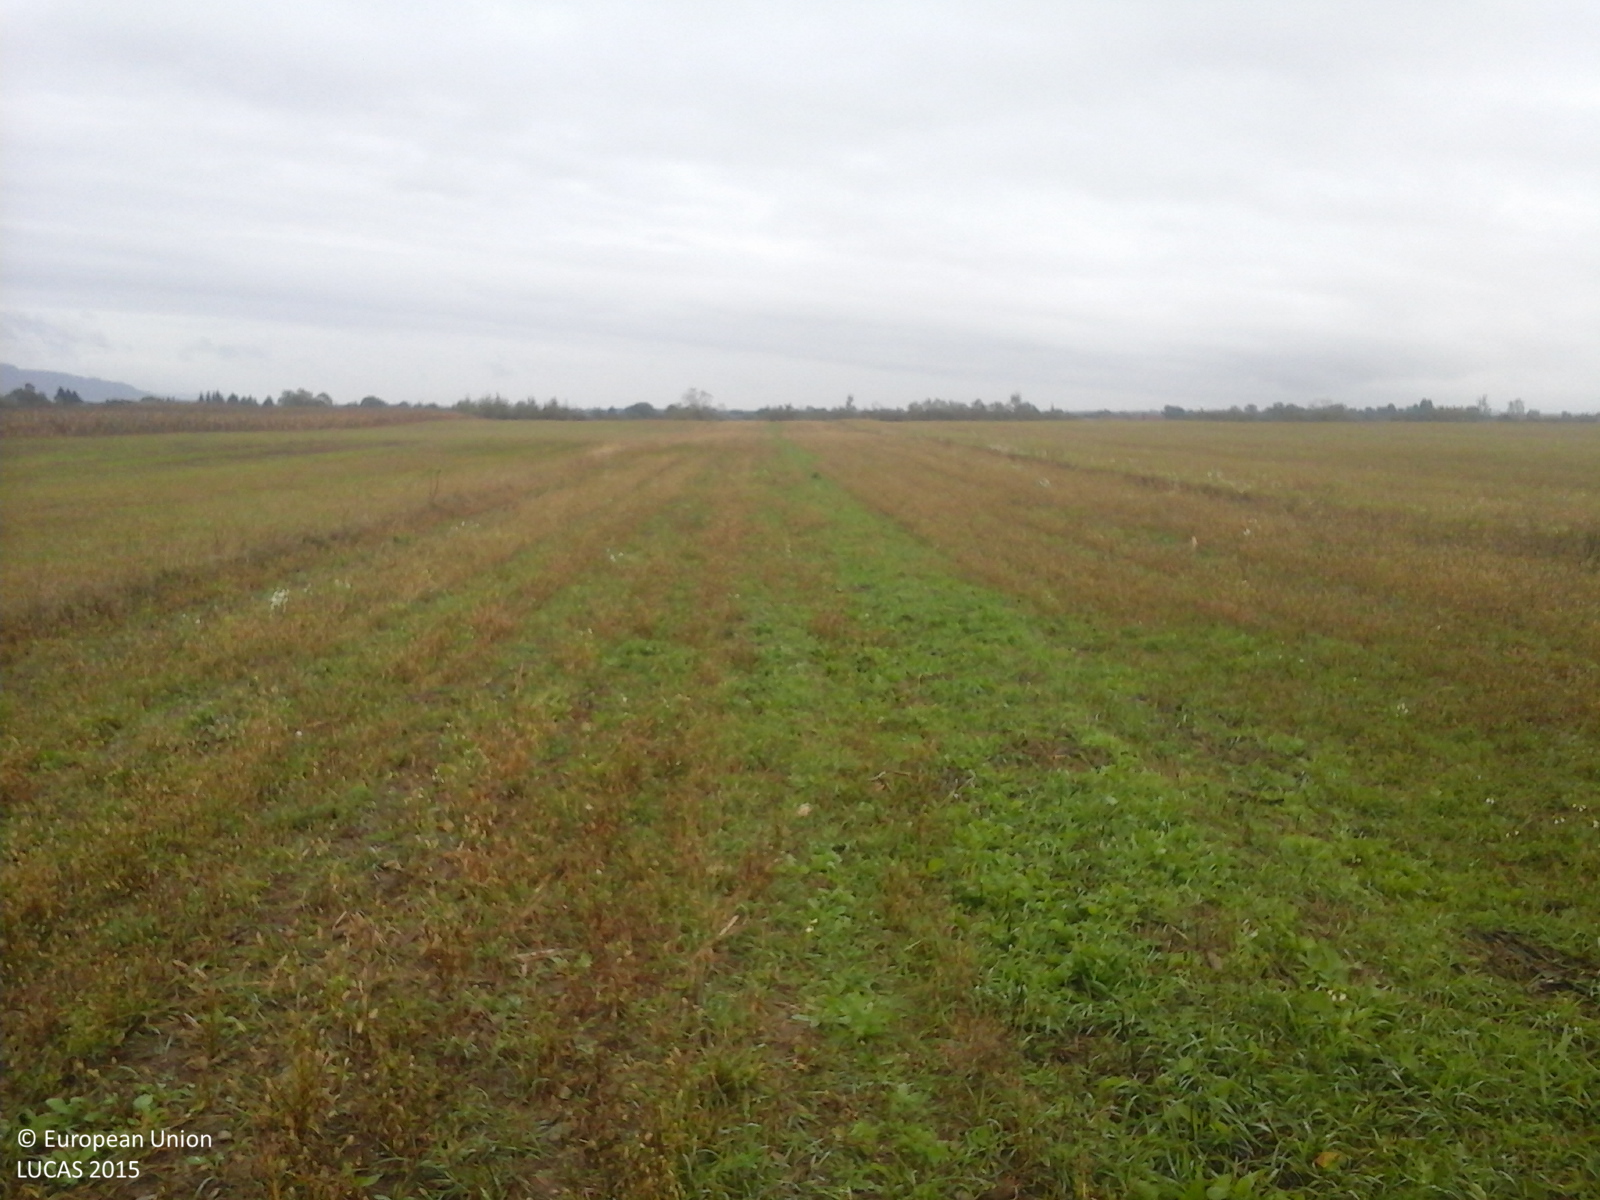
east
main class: Grassland
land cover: Grassland without tree/shrub cover
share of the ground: > 75 %
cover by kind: herbaceous plants 100 %
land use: Agriculture (excluding fallow land and kitchen gardens)
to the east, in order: Grassland without tree/shrub cover
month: October
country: RO
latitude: 45.7811
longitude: 24.6047
